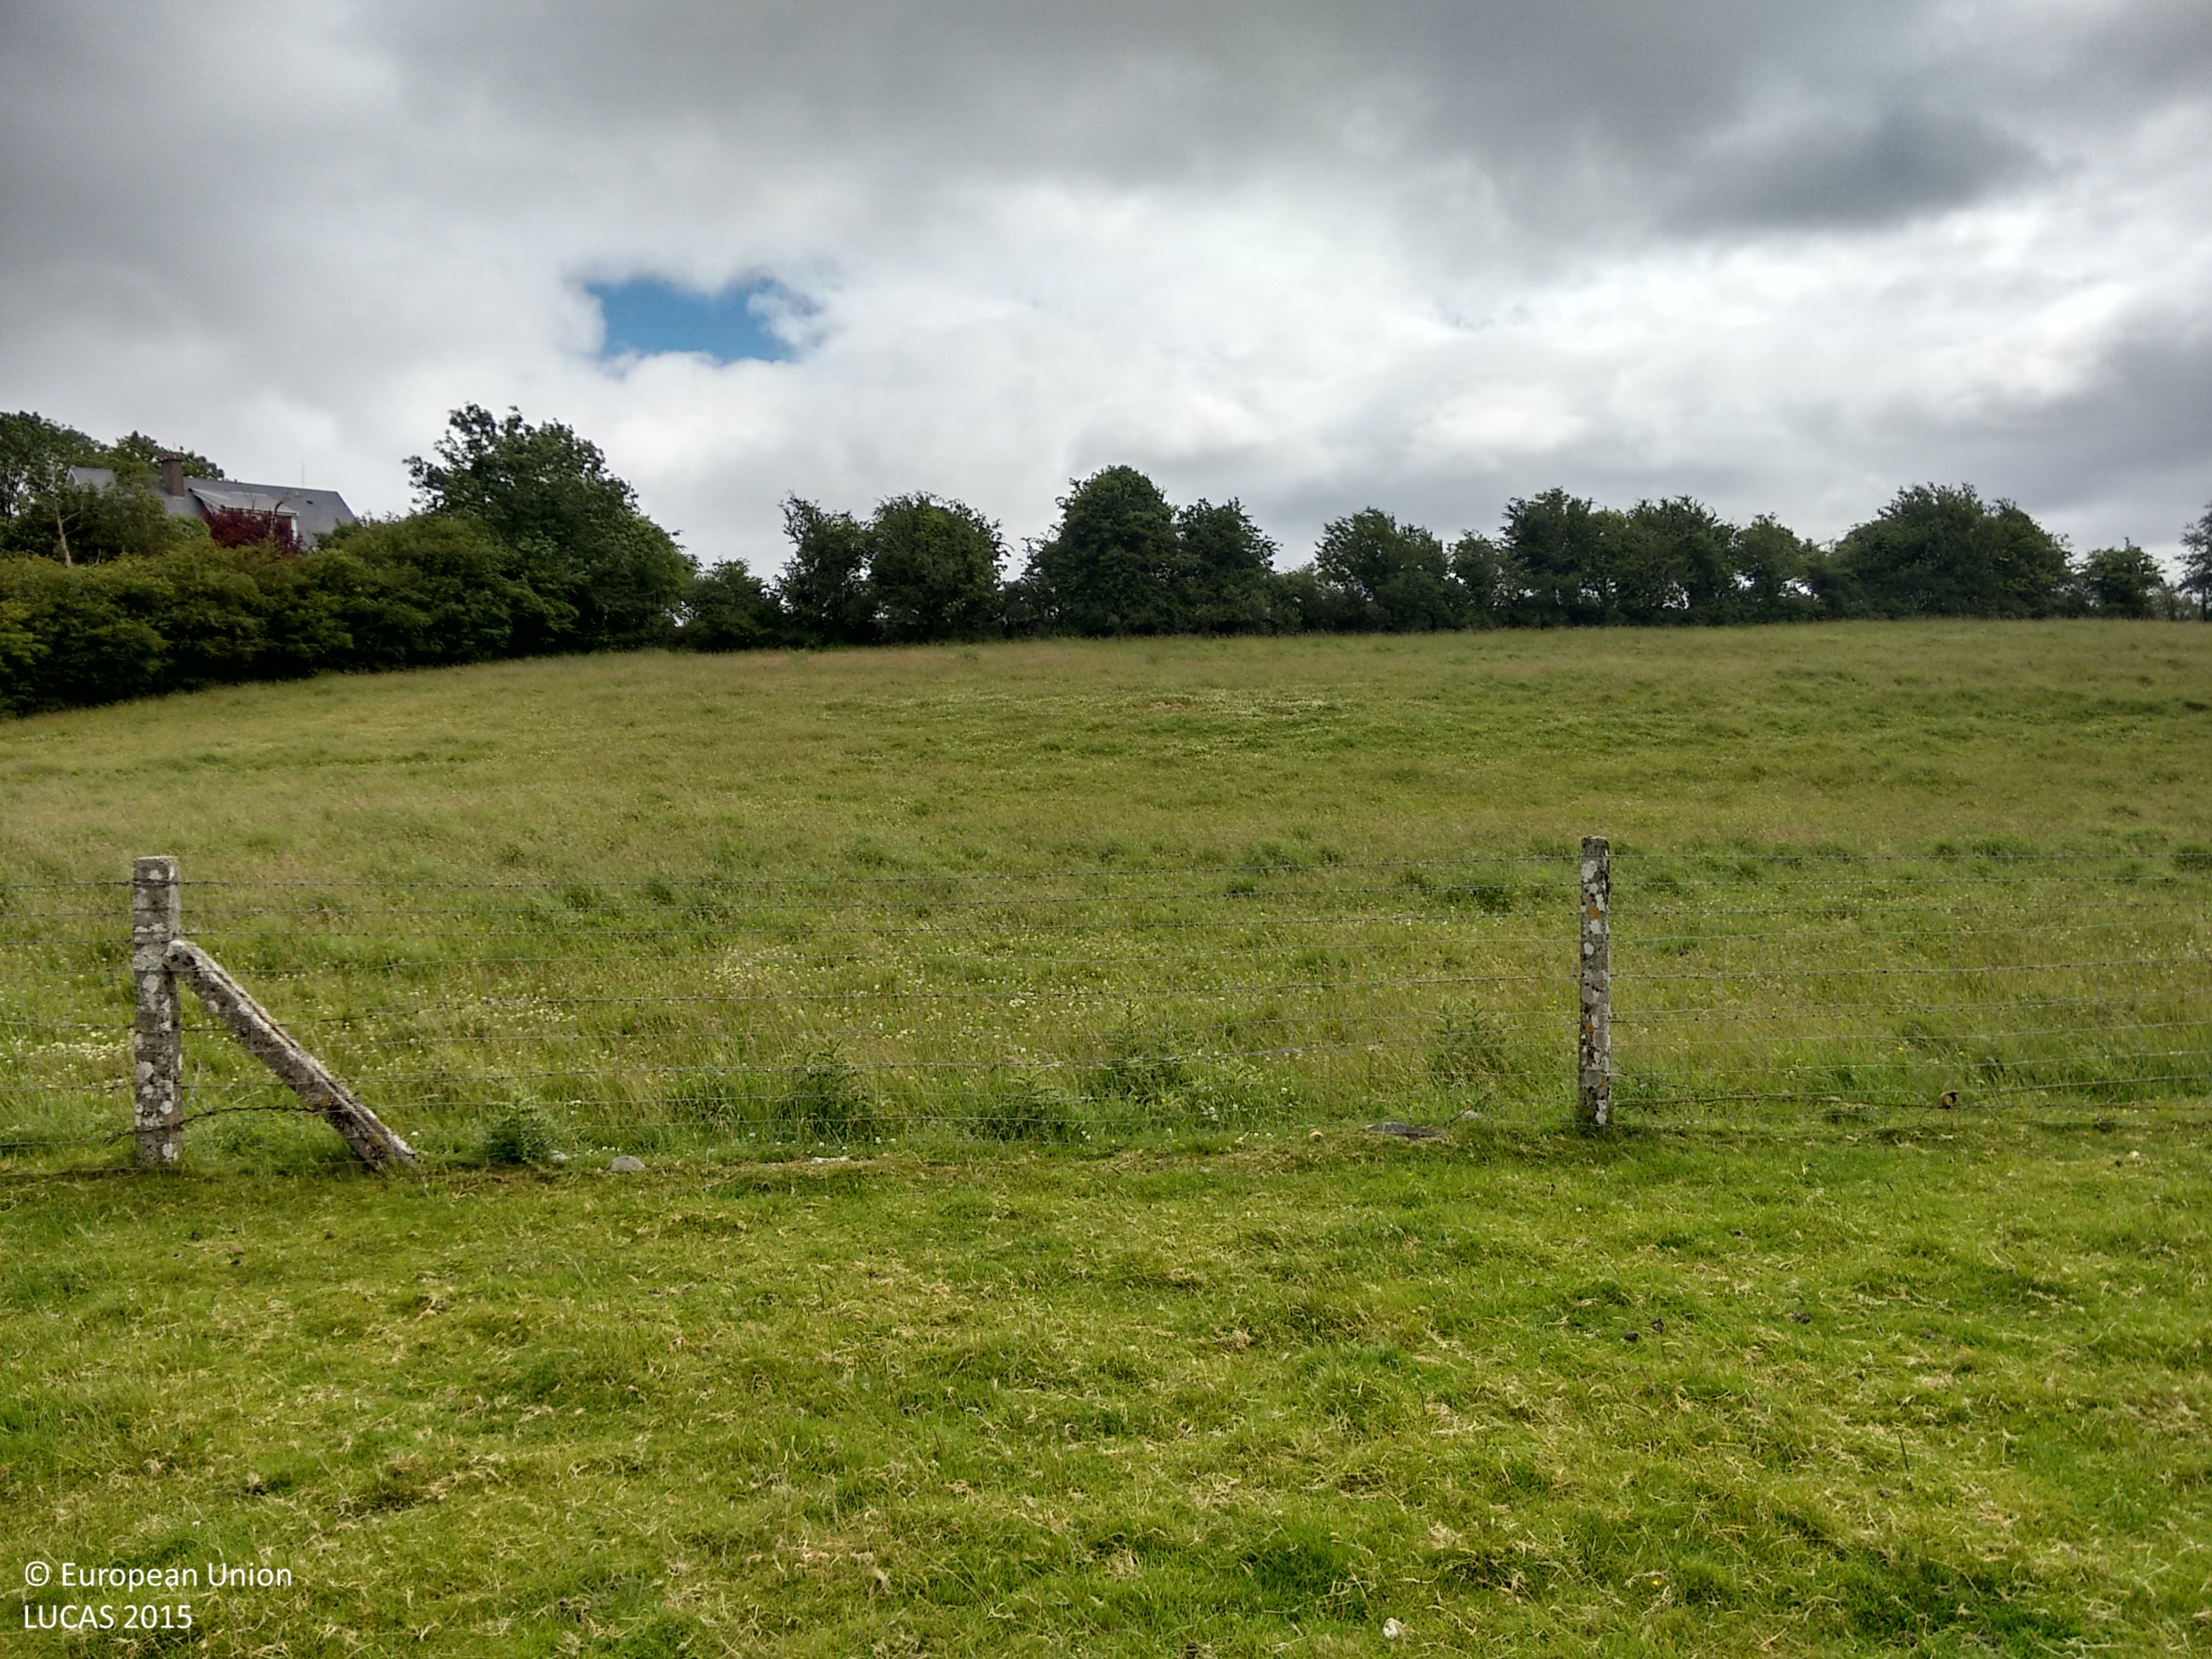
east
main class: Grassland
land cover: Grassland without tree/shrub cover
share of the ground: > 75 %
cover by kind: herbaceous plants 100 %
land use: Agriculture (excluding fallow land and kitchen gardens)
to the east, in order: Grassland without tree/shrub cover; Fences; Grassland without tree/shrub cover; Electric lines; Grassland without tree/shrub cover; Broadleaved woodland; Dry stone walls; Broadleaved woodland; Grassland without tree/shrub cover; Broadleaved woodland; Grassland without tree/shrub cover; Electric lines; Grassland without tree/shrub cover
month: June
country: IE
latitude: 53.4715
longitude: -8.0286
